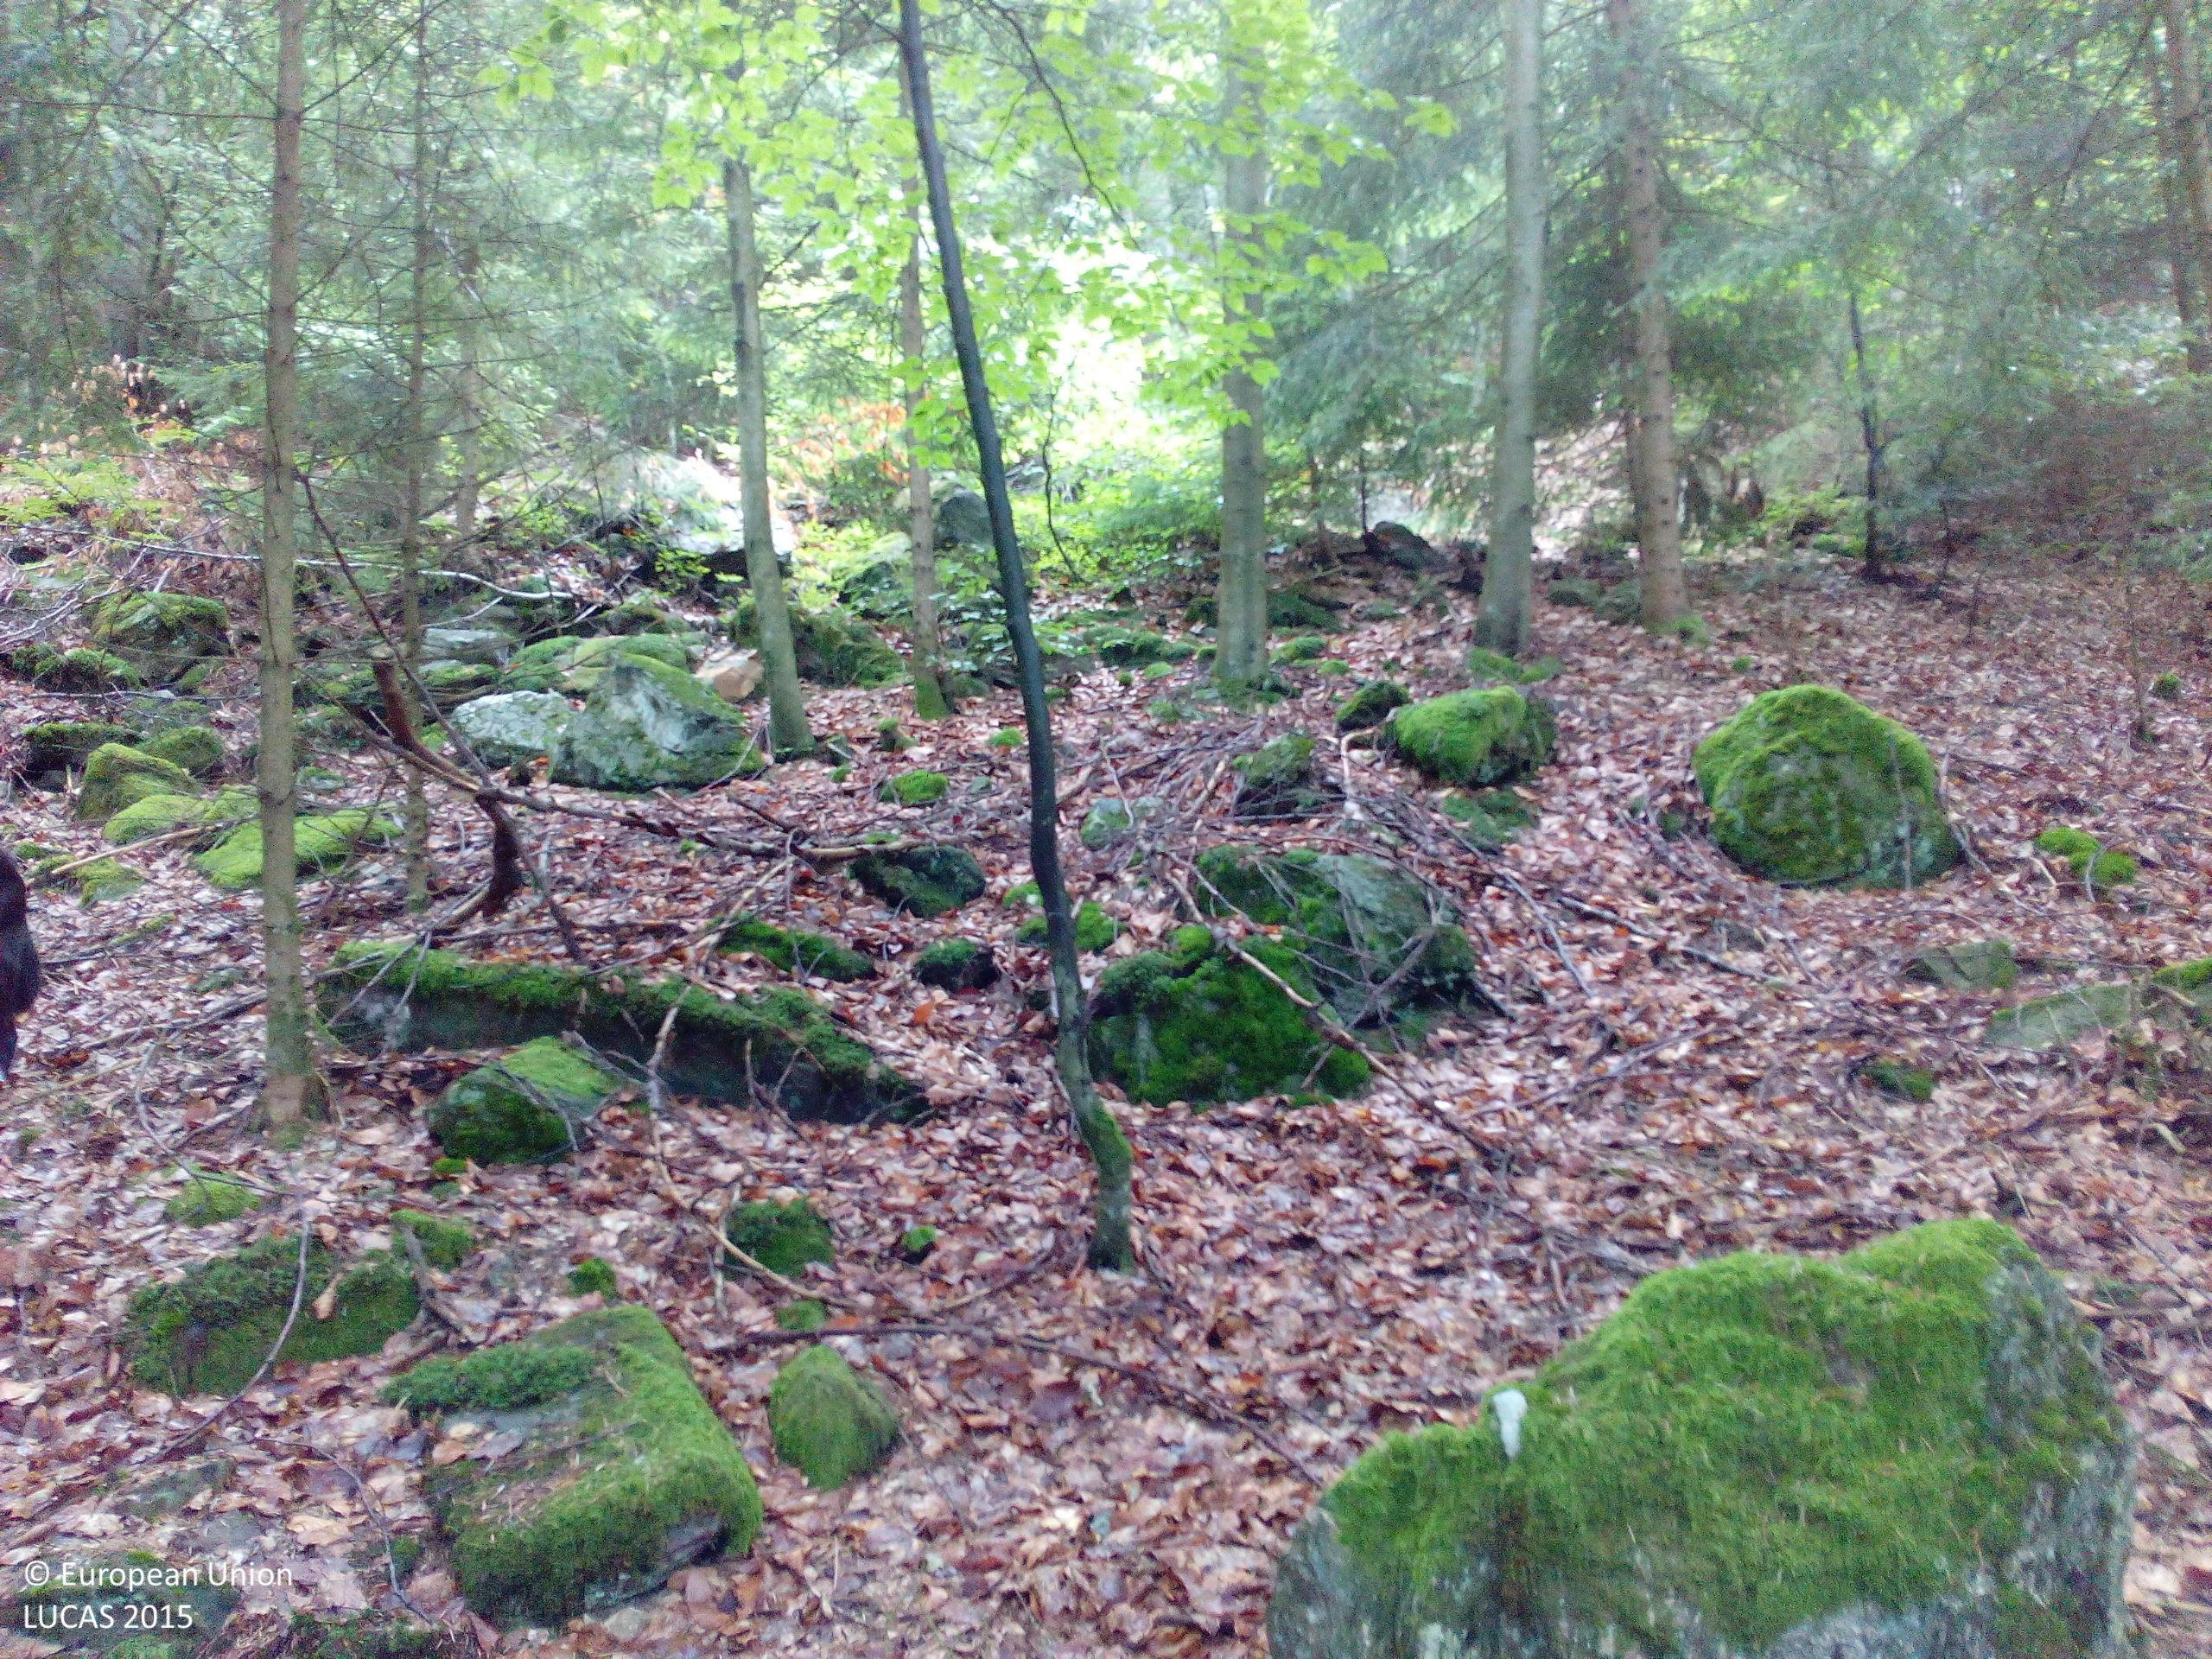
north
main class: Woodland
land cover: Spruce dominated mixed woodland
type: hemiboreal forest and nemoral coniferous forest and mixed broadleaved-coniferous forest
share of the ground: > 75 %
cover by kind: coniferous forest trees 60 %, broadleaved forest trees 25 %, unconsolidated bare surface 10 %, lichens and mosses 5 %
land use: Forestry
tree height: > 5 m
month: July
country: DE
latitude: 49.1556
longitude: 12.9751
